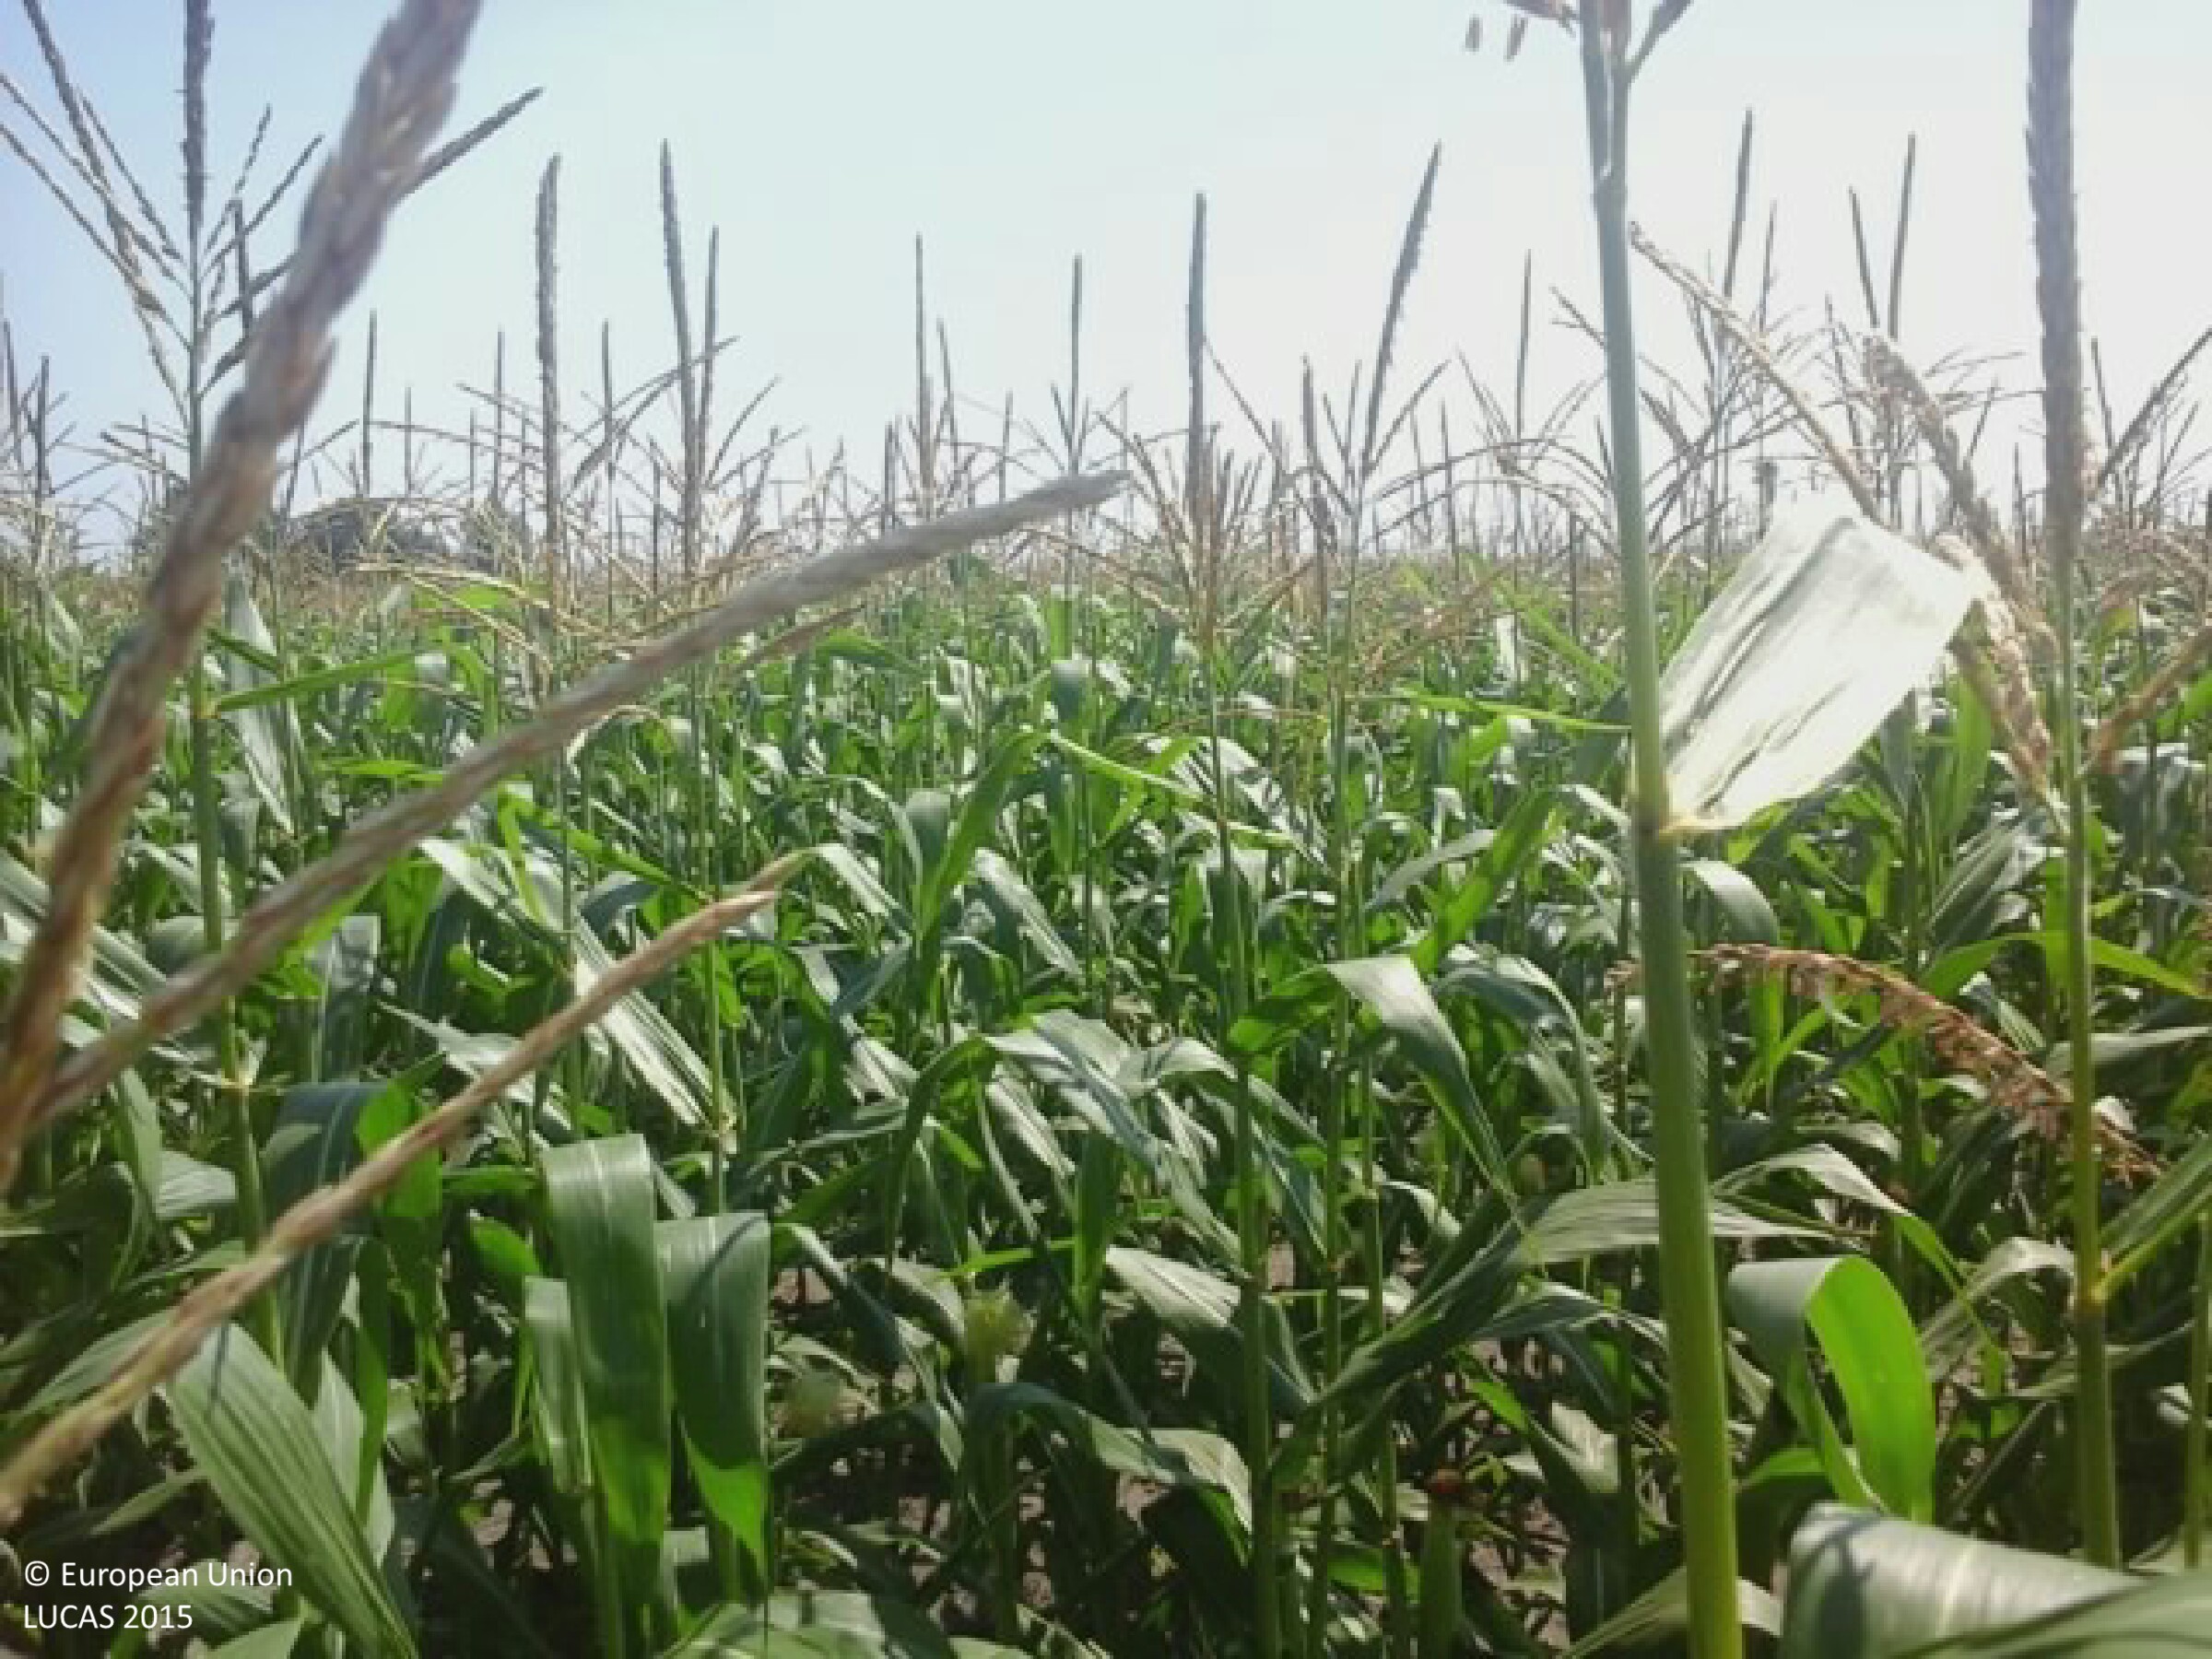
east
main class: Cropland
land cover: Maize
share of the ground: > 75 %
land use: Agriculture (excluding fallow land and kitchen gardens)
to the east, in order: Maize; Spontaneously vegetated surfaces; Inland fresh running water; Spontaneously vegetated surfaces
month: August
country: HU
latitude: 47.1290
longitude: 19.2326
